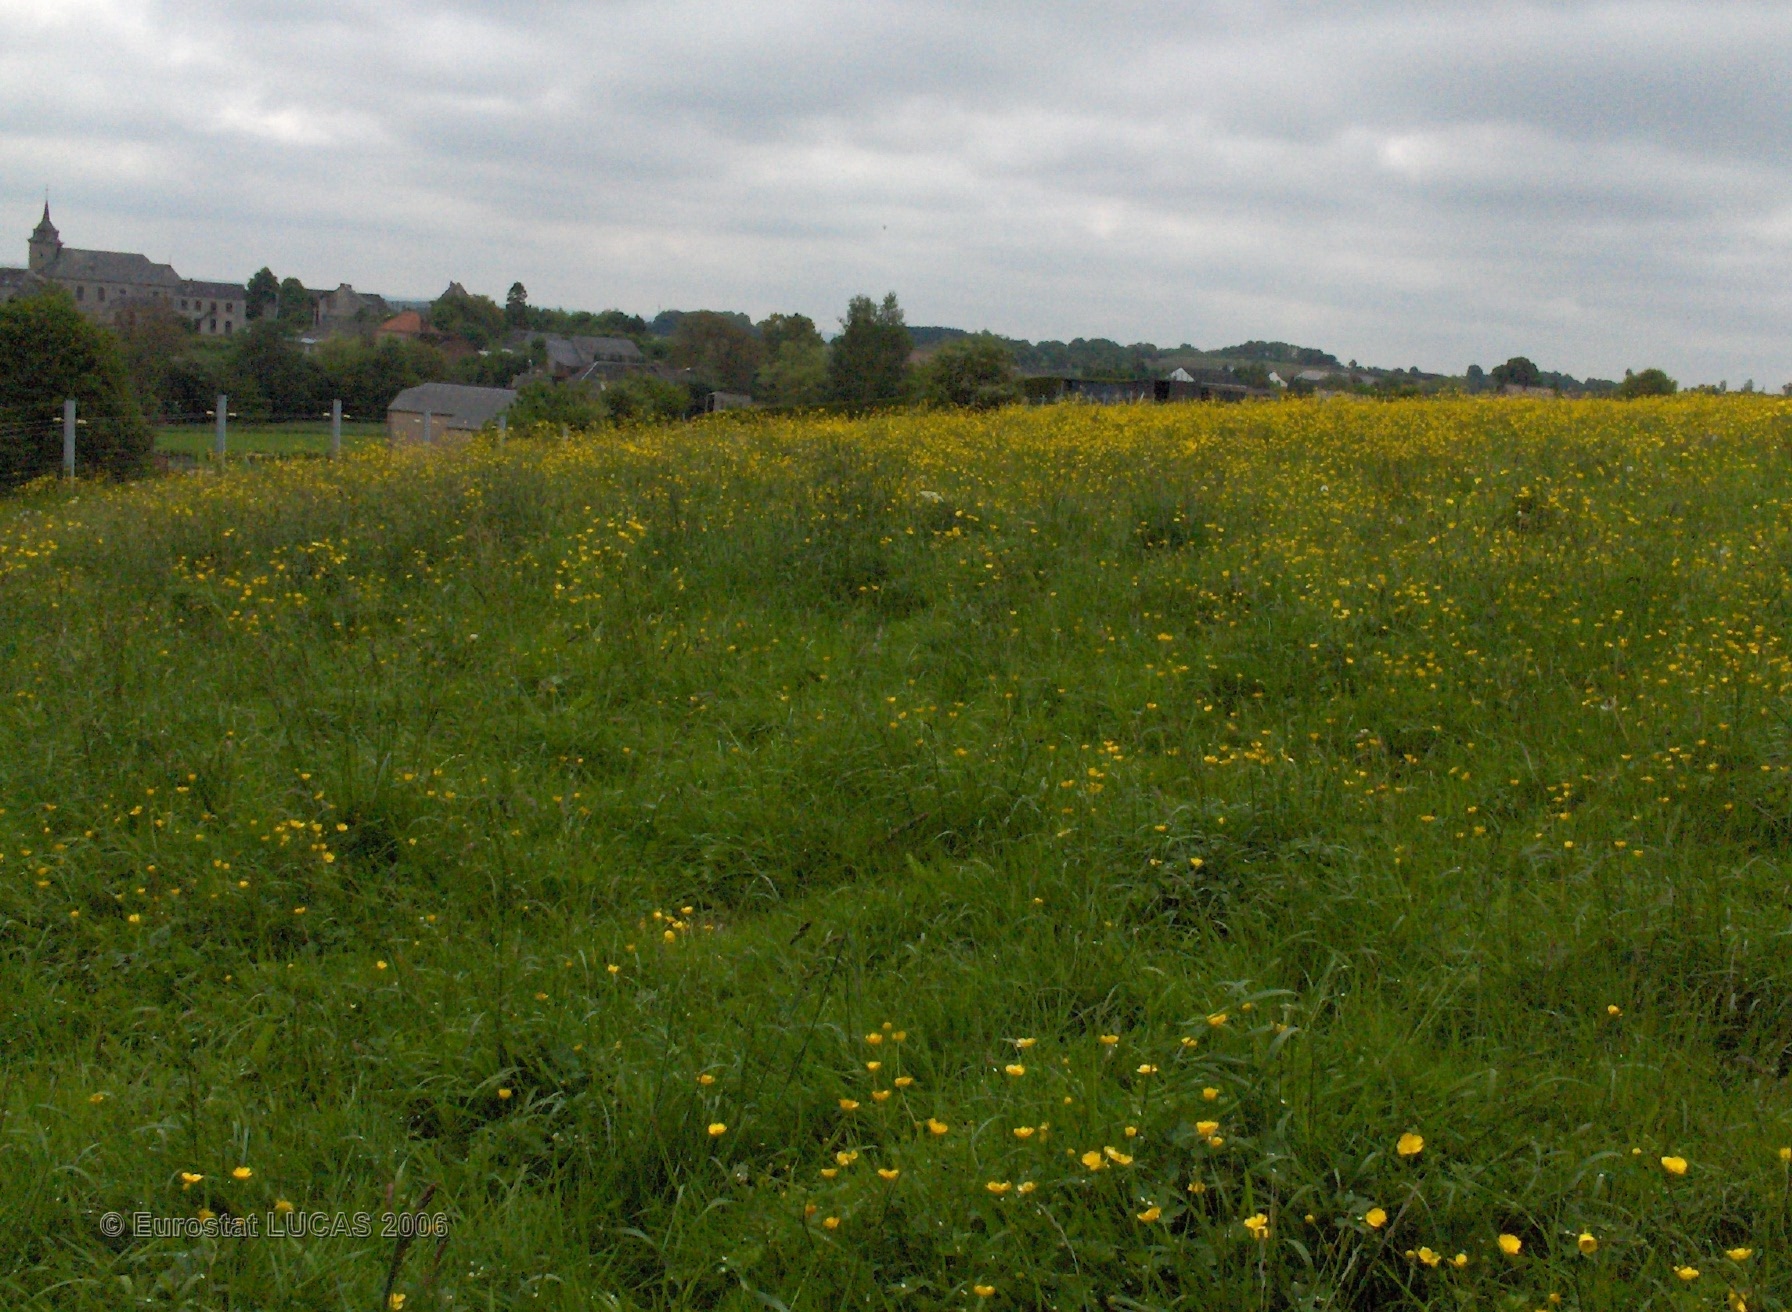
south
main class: Grassland
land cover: Grassland without tree/shrub cover
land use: Agriculture (excluding fallow land and kitchen gardens)
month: June
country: BE
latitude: 50.1787
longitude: 4.5207
